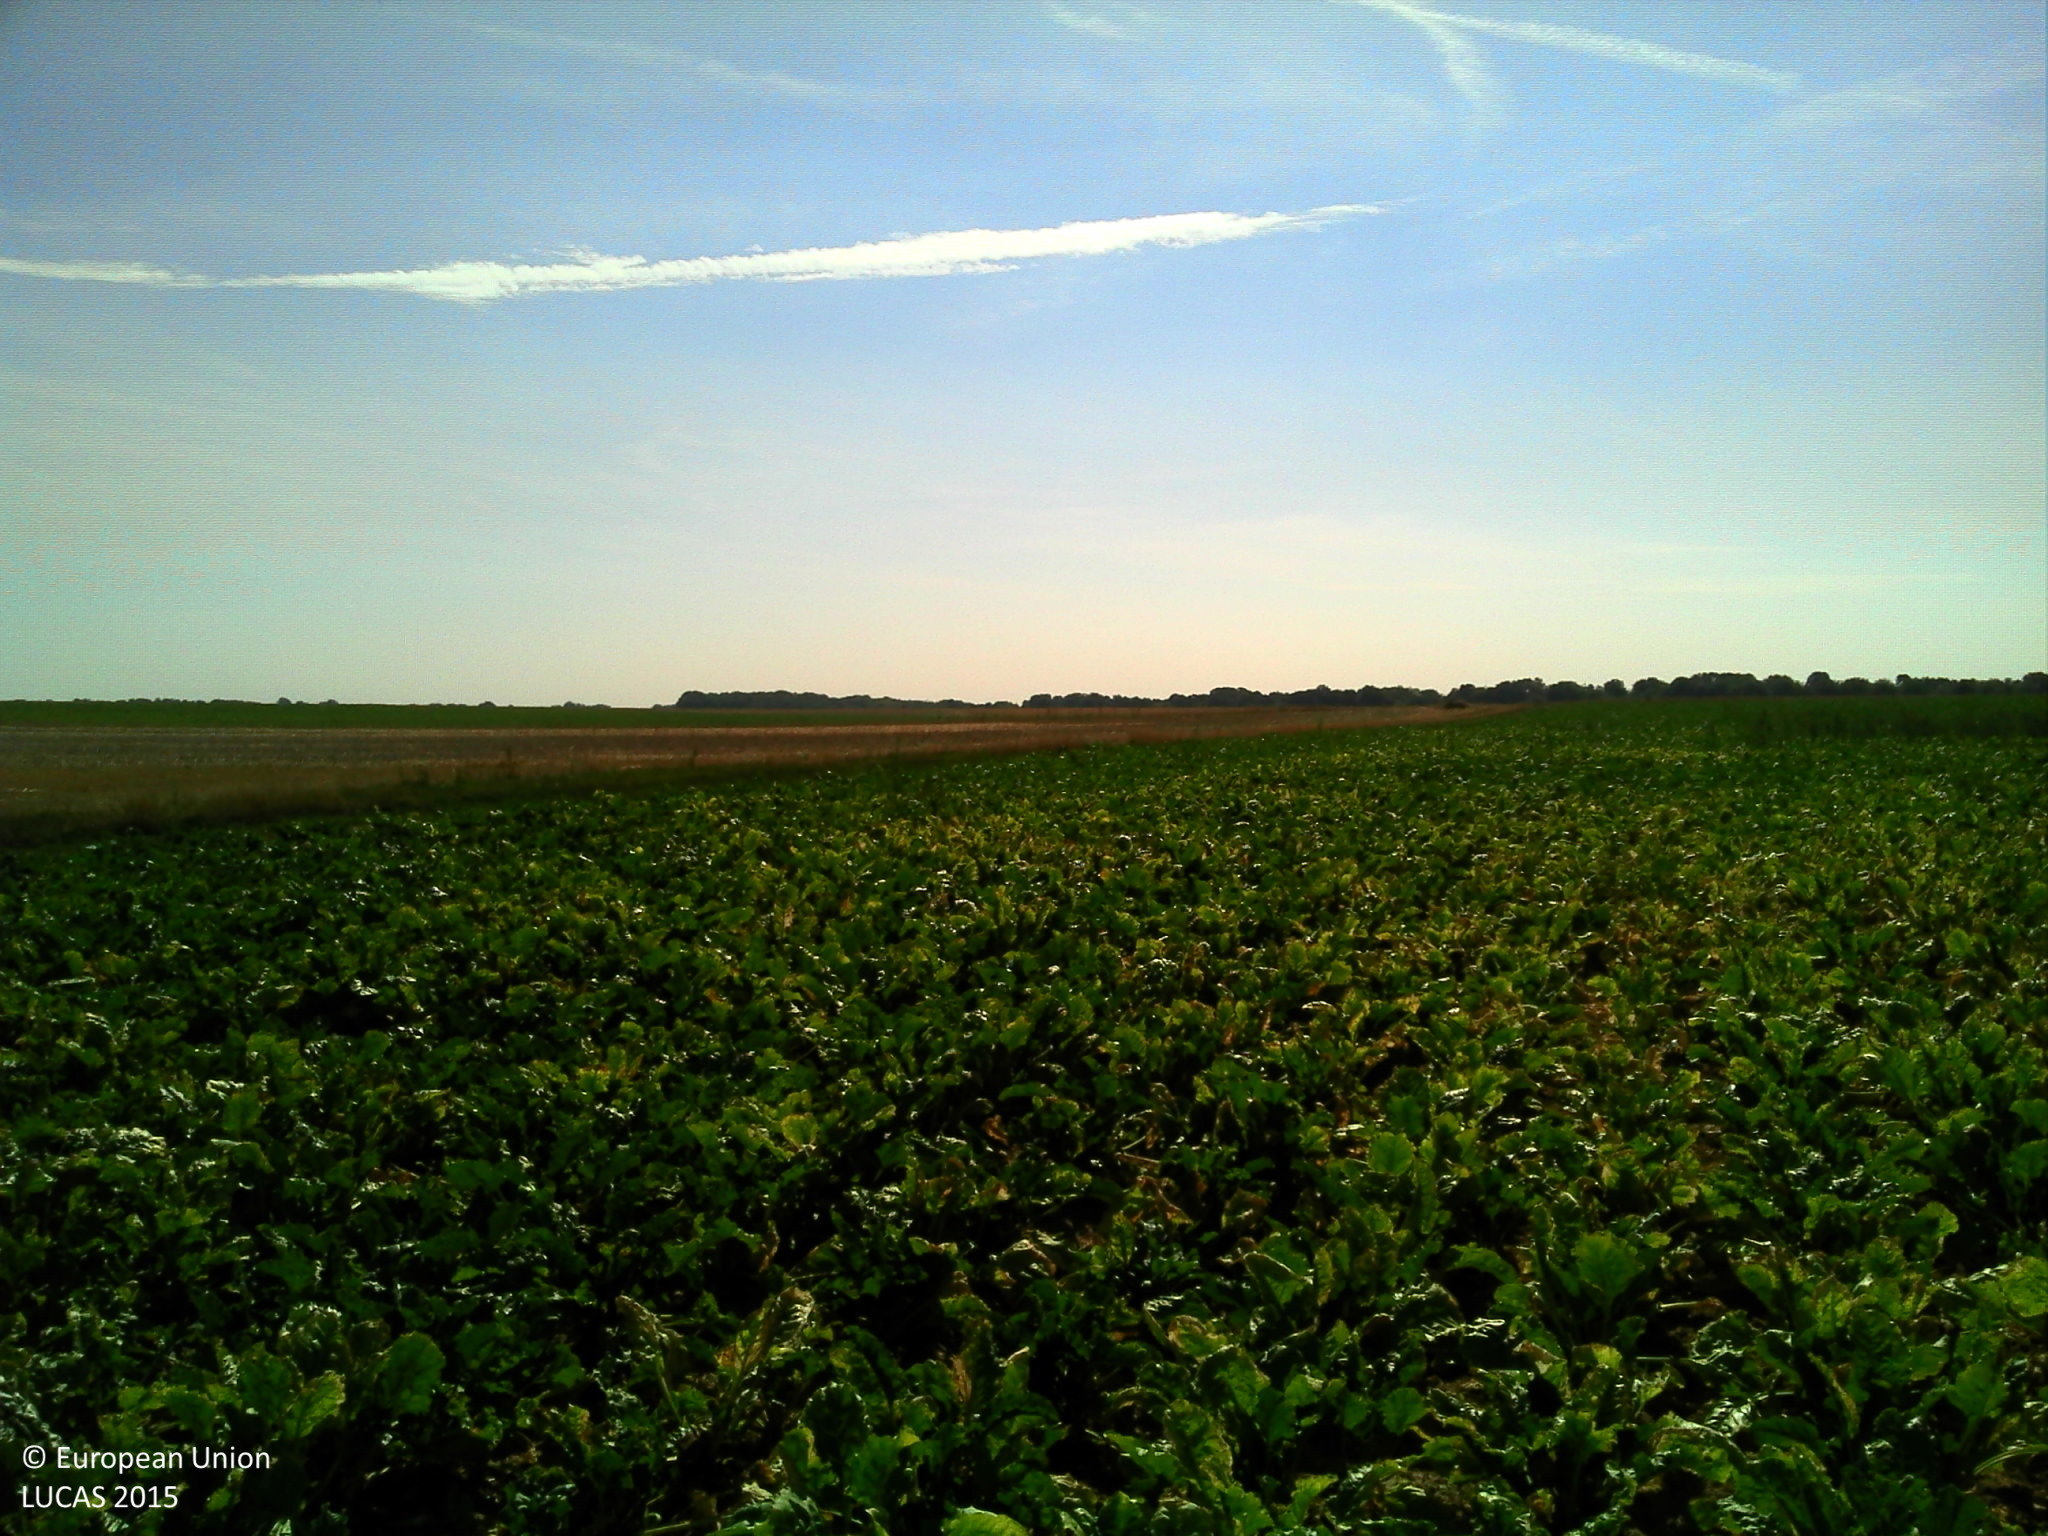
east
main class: Cropland
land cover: Sugar beet
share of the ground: > 75 %
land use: Agriculture (excluding fallow land and kitchen gardens)
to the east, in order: Sugar beet; Tracks; Barley; Other root crops; Tracks; Sugar beet
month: August
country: FR
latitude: 48.3368
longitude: 2.6110
